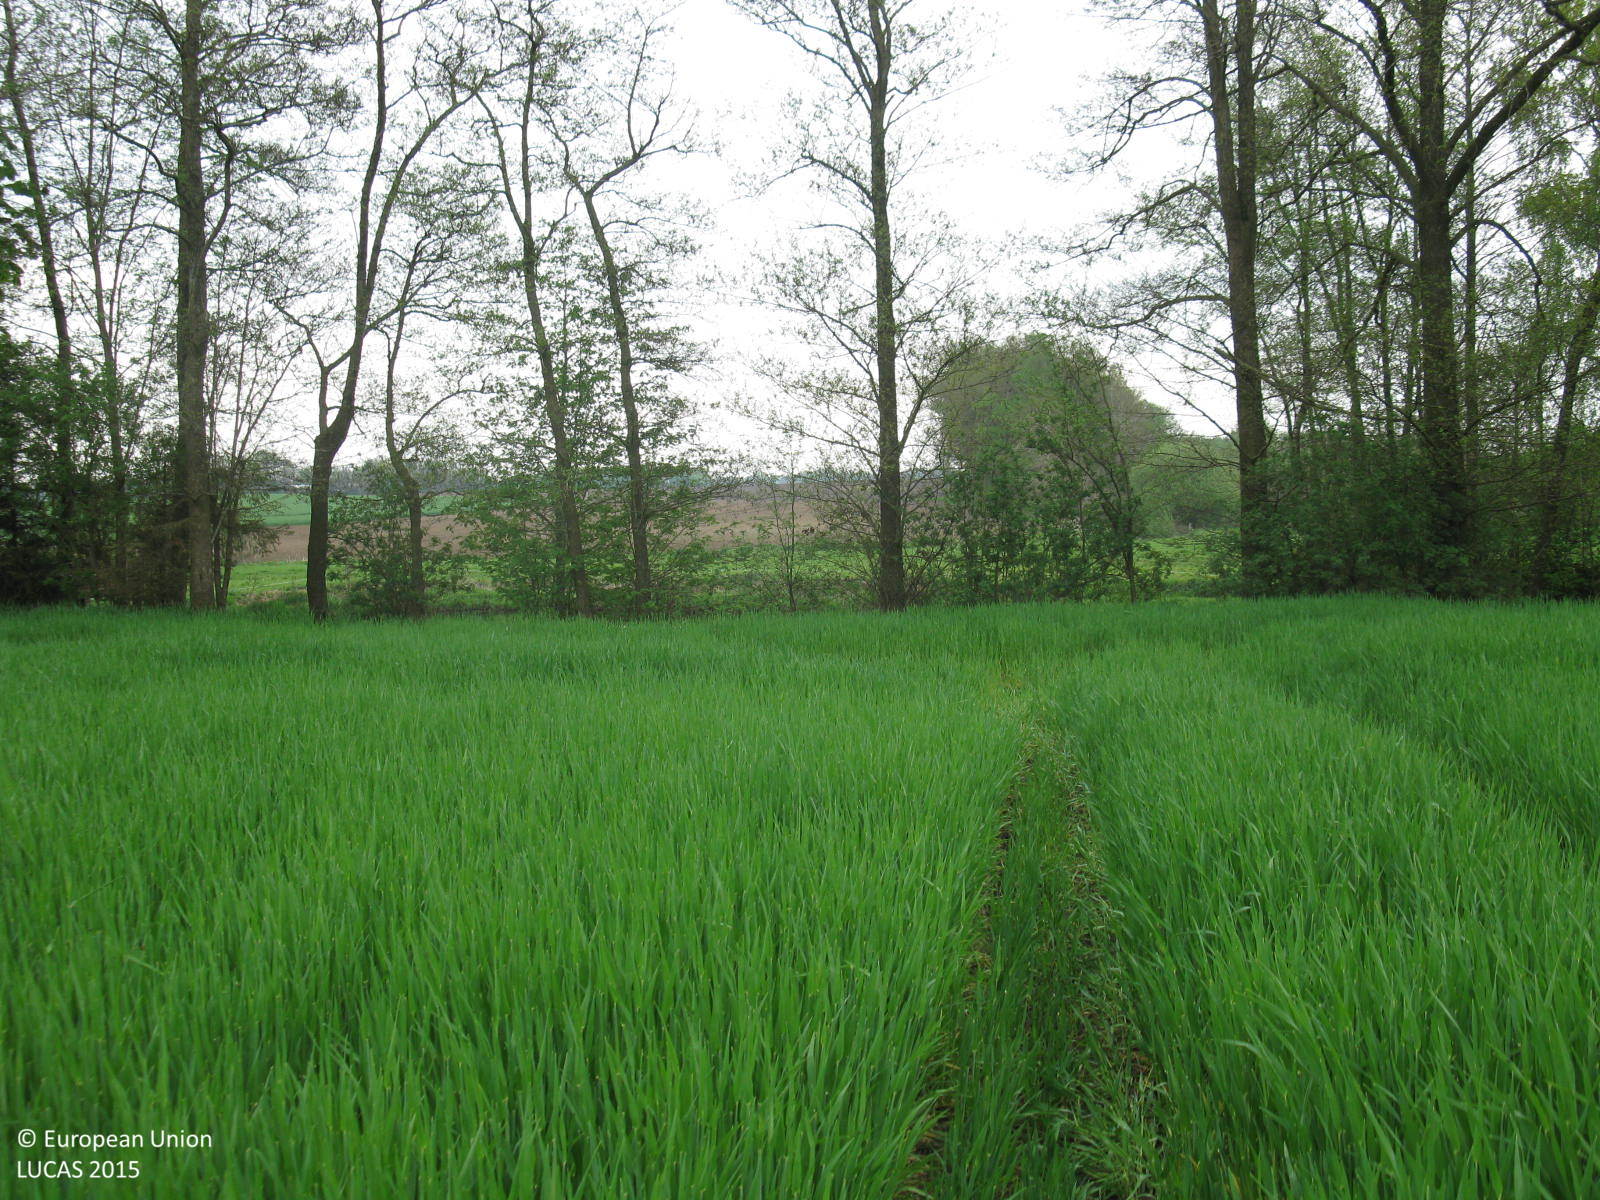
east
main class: Cropland
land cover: Barley
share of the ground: > 75 %
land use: Agriculture (excluding fallow land and kitchen gardens)
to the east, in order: Barley; Broadleaved woodland; Inland fresh water bodies; Grassland without tree/shrub cover; Fences; Grassland without tree/shrub cover; Fences; Inland fresh running water; Rape and turnip rape; Rye
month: May
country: DE
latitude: 52.8809
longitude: 7.9351
